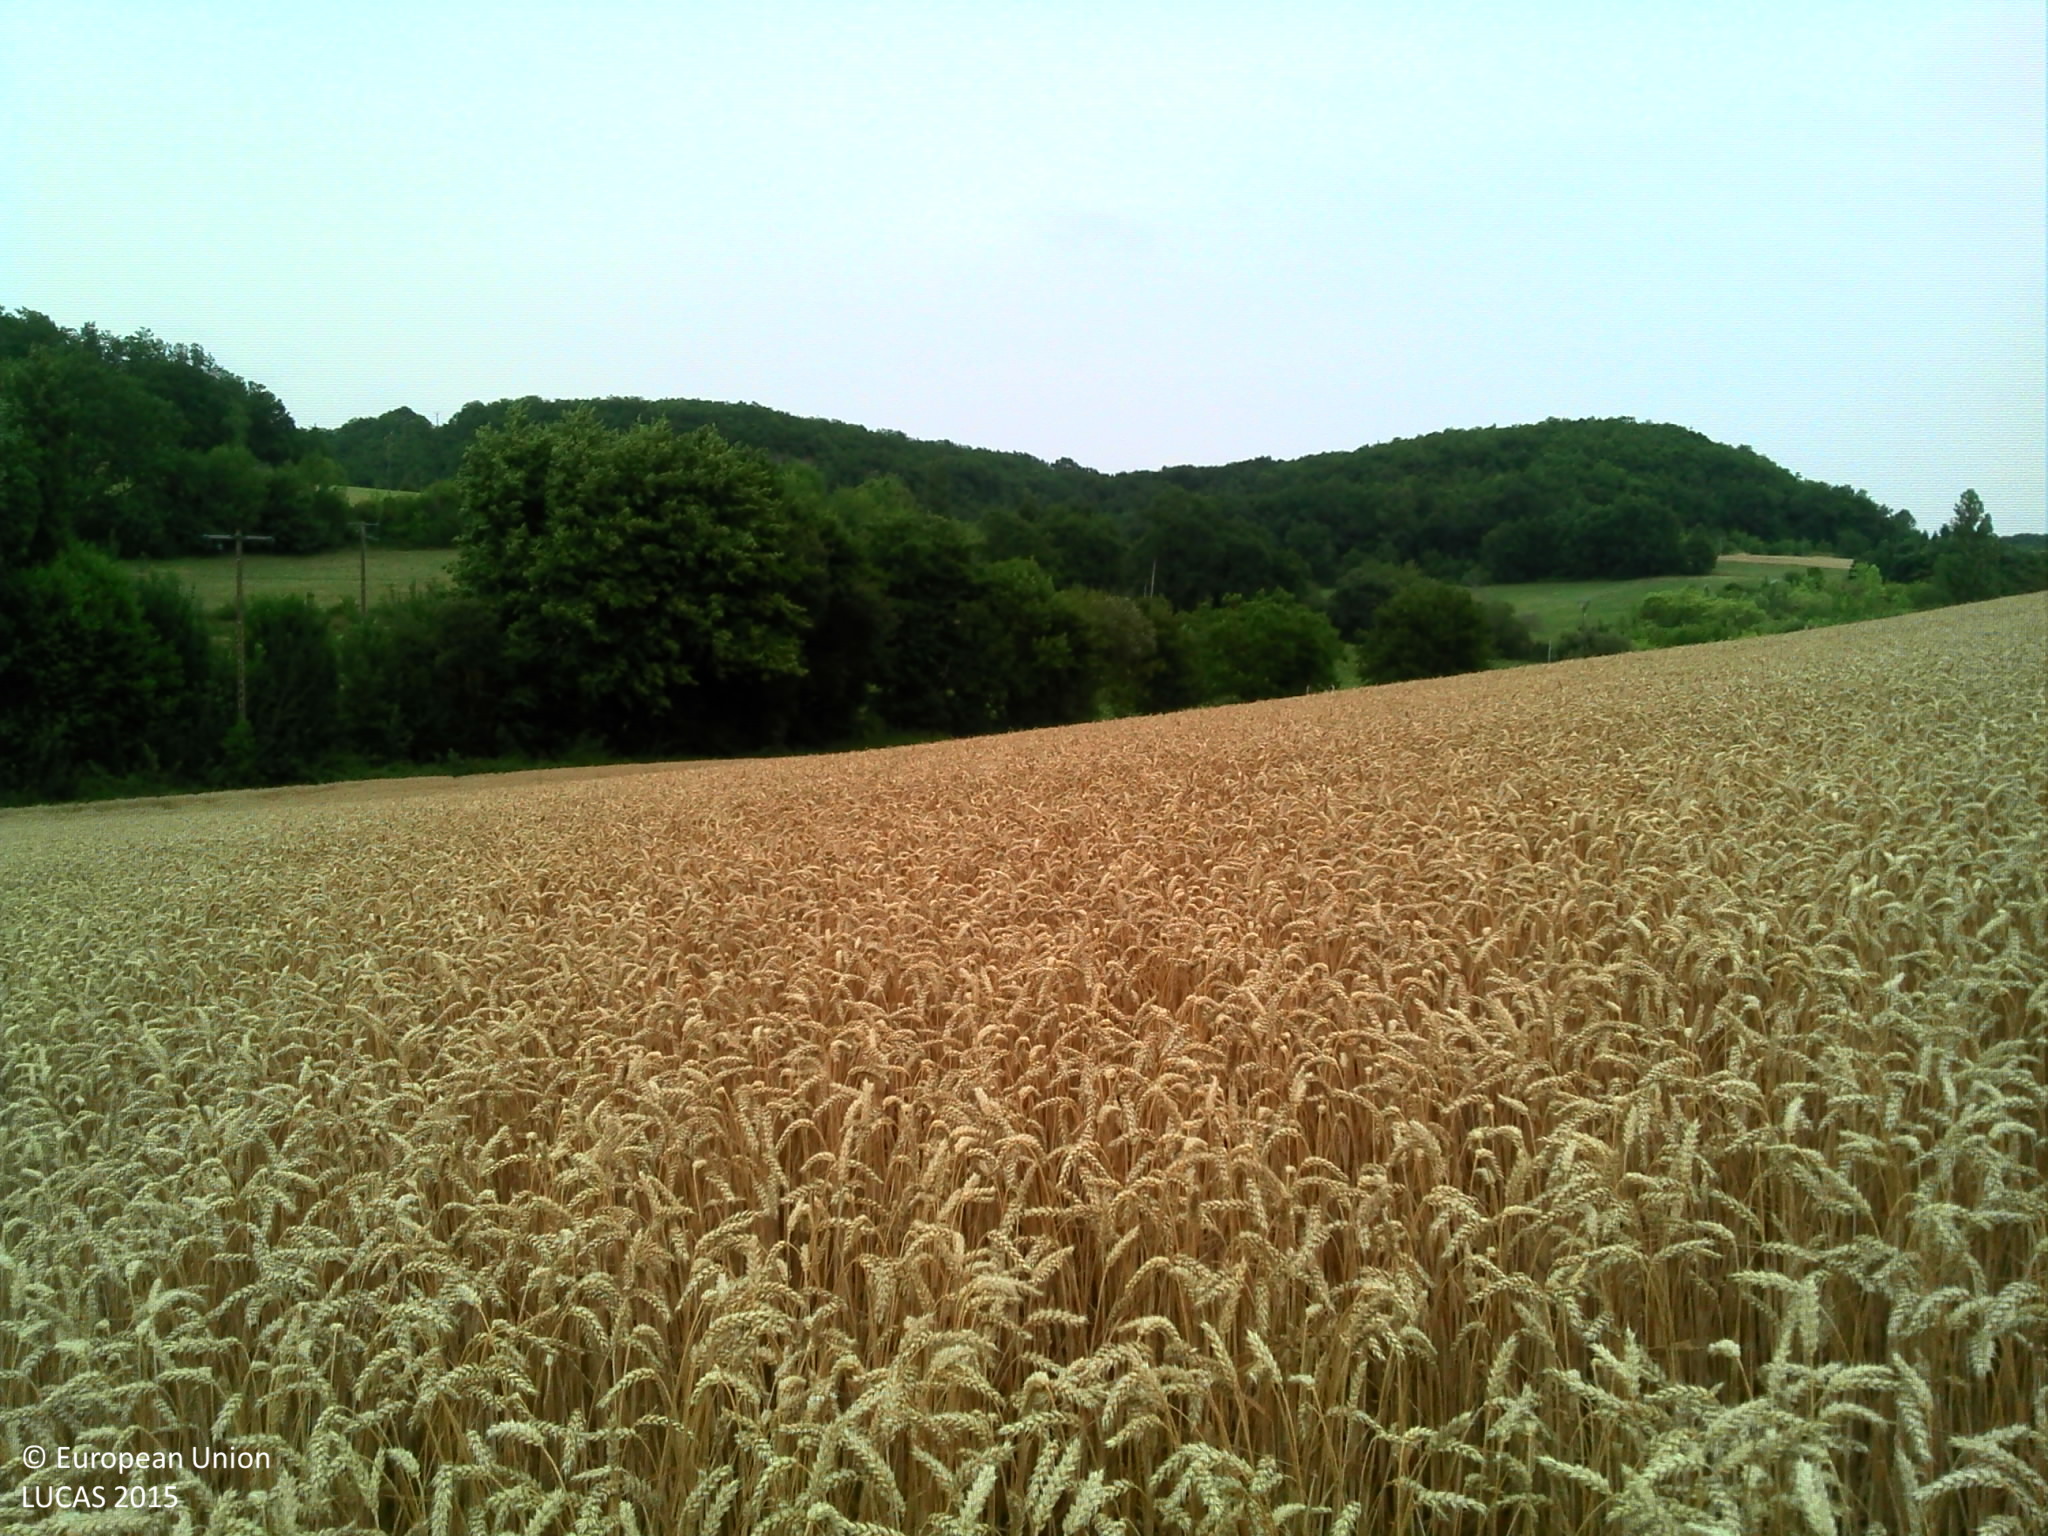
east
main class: Cropland
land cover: Common wheat
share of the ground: > 75 %
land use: Agriculture (excluding fallow land and kitchen gardens)
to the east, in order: Common wheat; Abandoned hedges; Lines of trees; Rivers and streams; Abandoned hedges; Grass margins; Sunflower; Electric lines; Sunflower
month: July
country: FR
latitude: 44.3426
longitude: 0.8261
